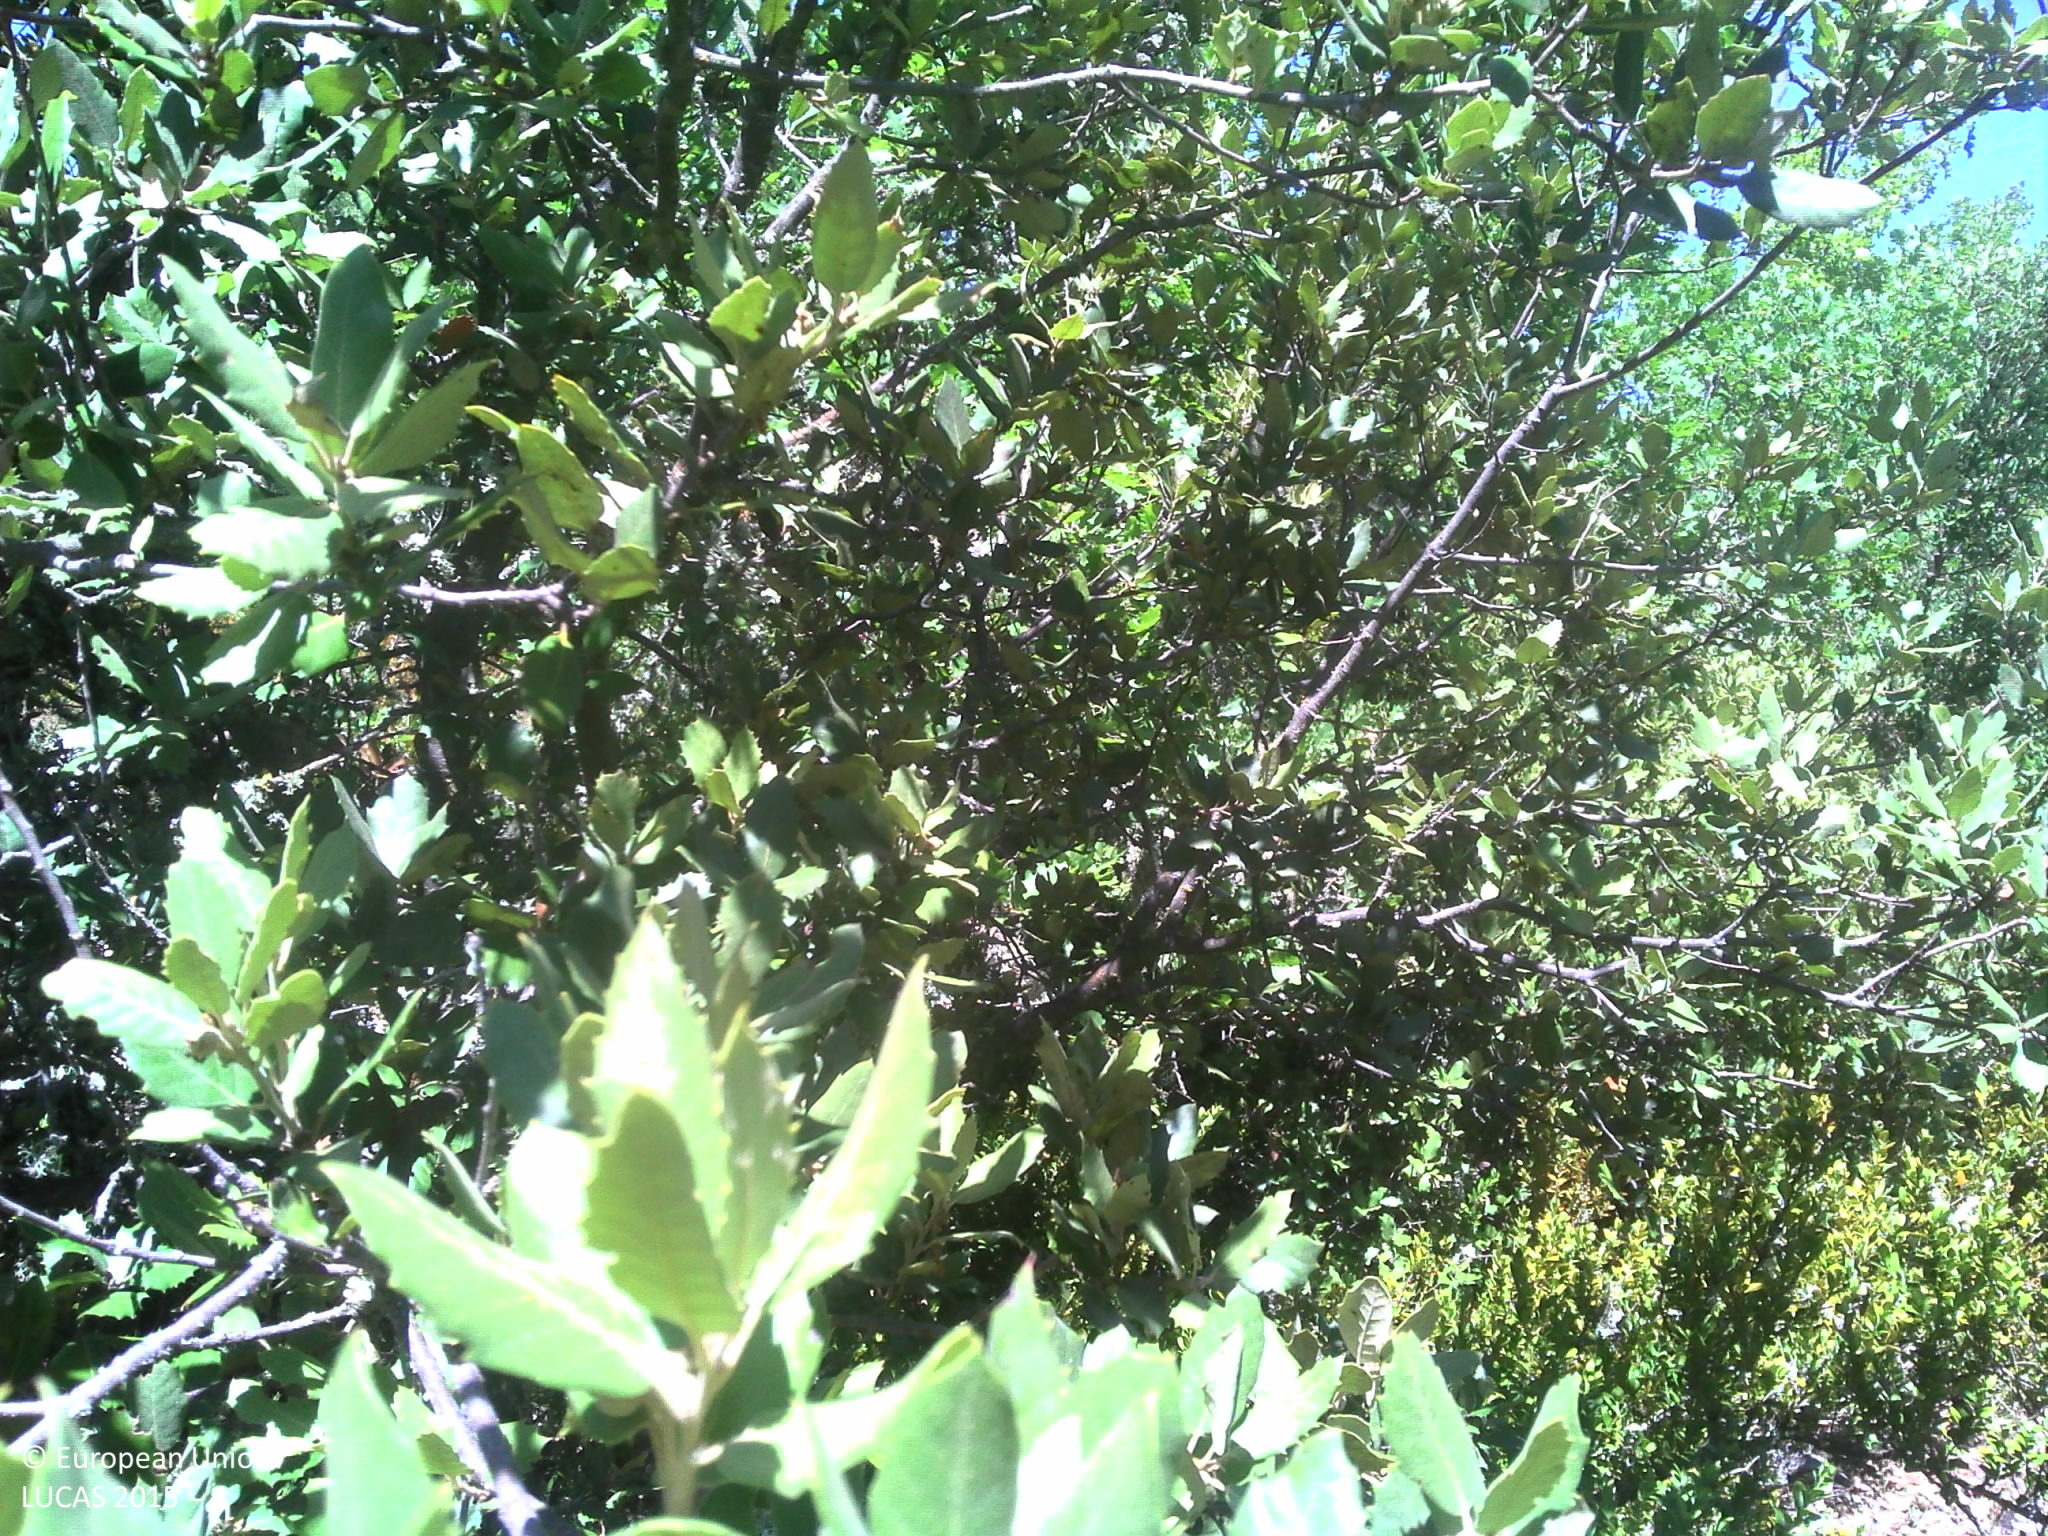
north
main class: Woodland
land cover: Broadleaved woodland
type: thermophilous deciduous forest
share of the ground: 50 - 75 %
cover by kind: broadleaved forest trees 75 %, shrubs 25 %
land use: Forestry
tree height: > 5 m
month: July
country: FR
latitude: 43.9316
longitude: 5.5864
